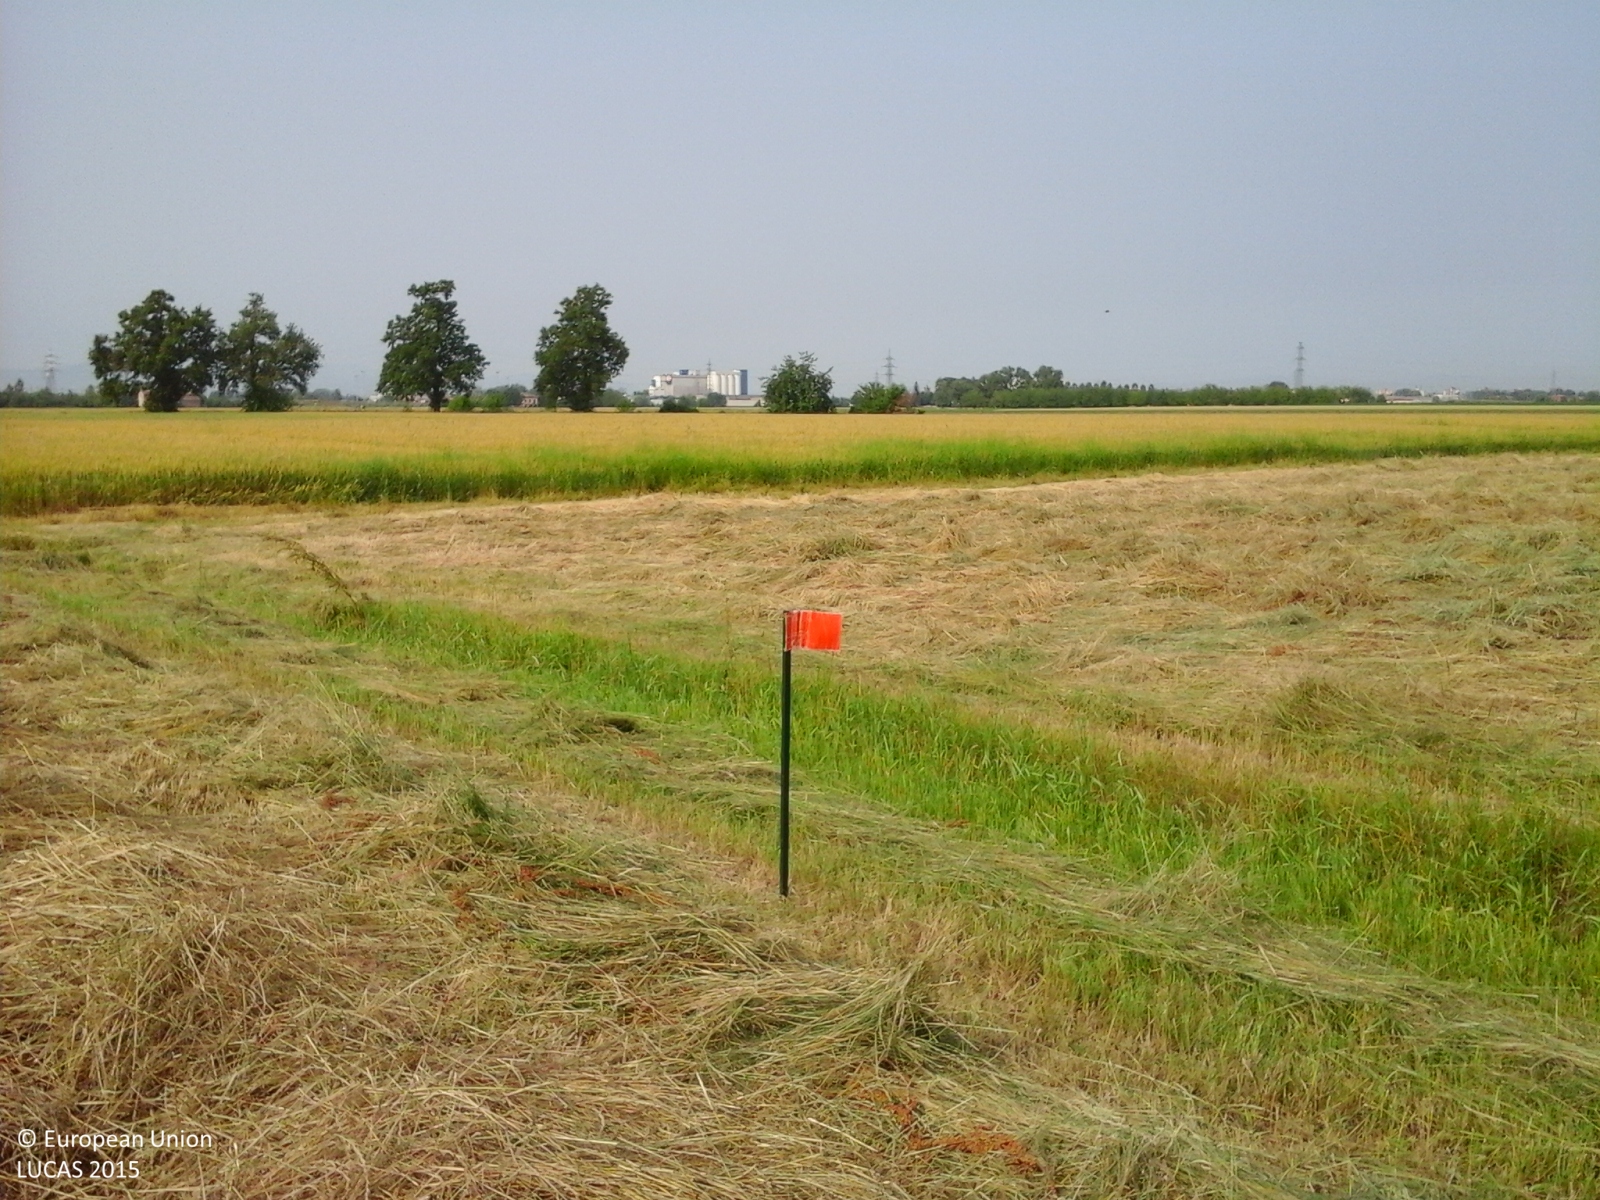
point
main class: Cropland
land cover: Temporary grasslands
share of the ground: > 75 %
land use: Agriculture (excluding fallow land and kitchen gardens)
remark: Clear cut
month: June
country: IT
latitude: 44.8367
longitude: 10.3913
